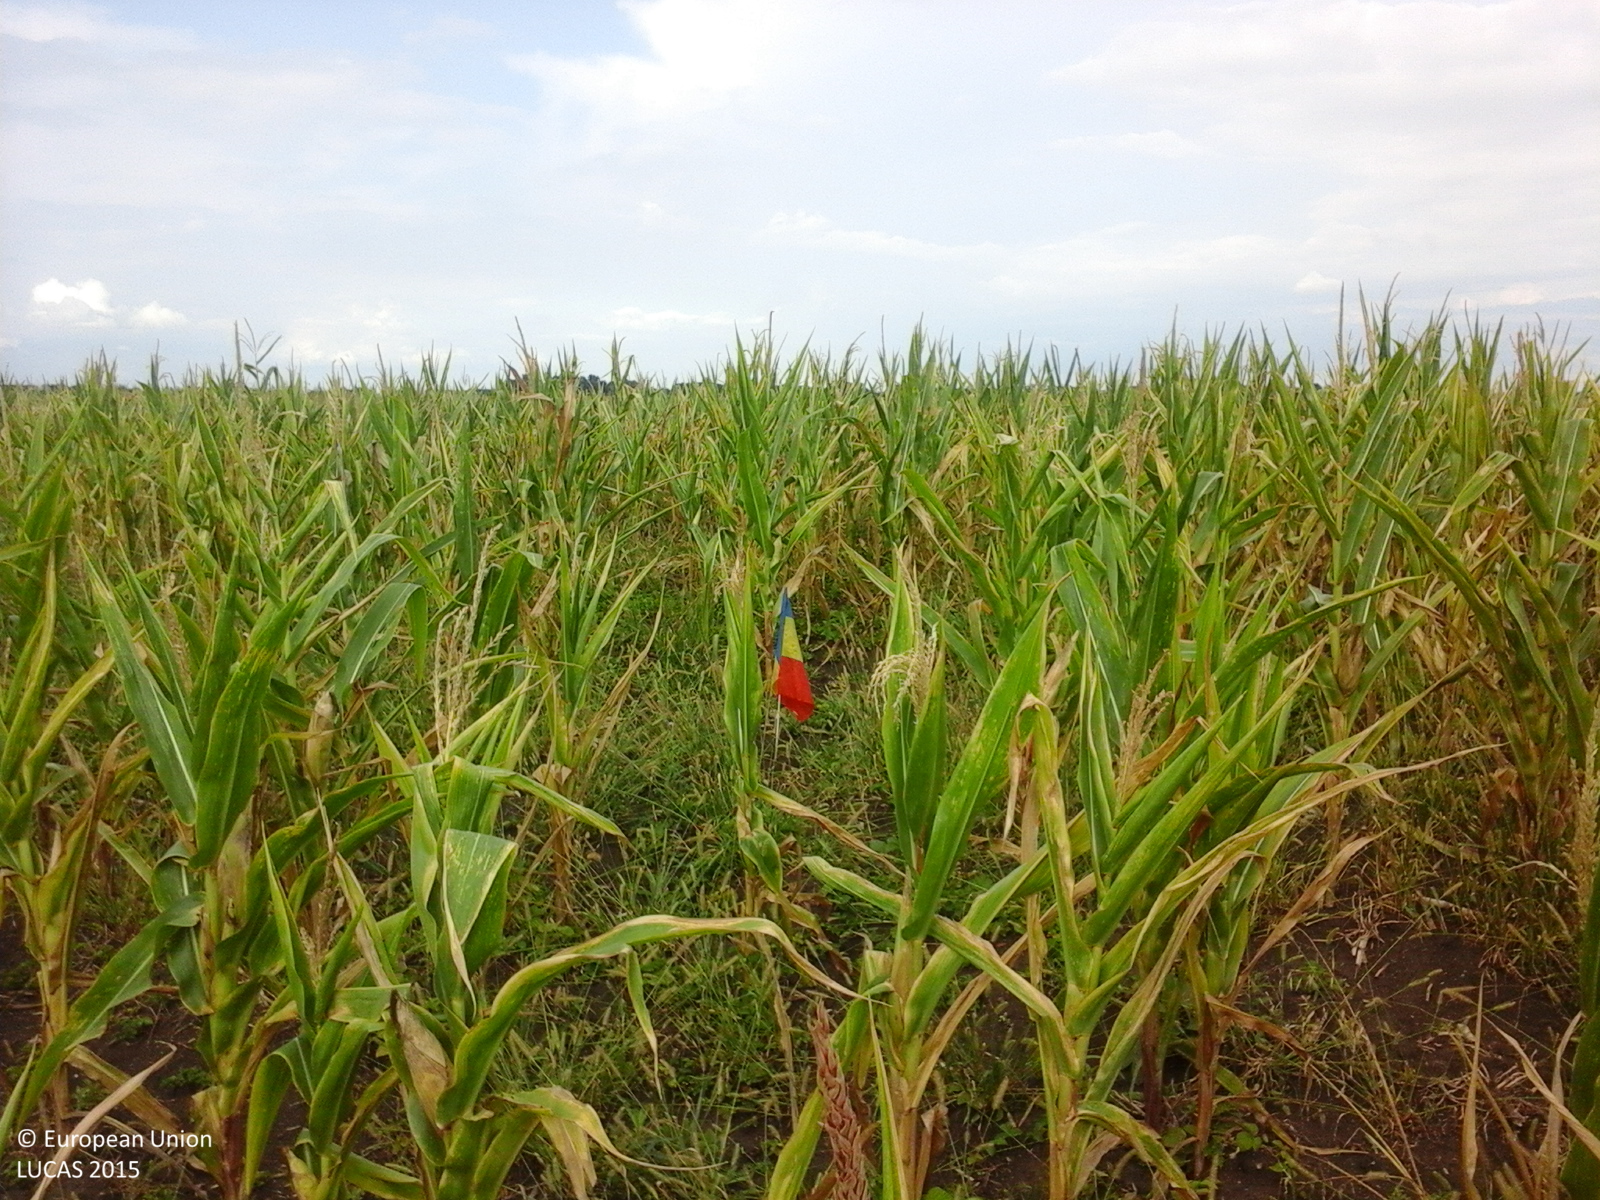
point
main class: Cropland
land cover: Maize
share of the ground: > 75 %
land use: Agriculture (excluding fallow land and kitchen gardens)
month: August
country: RO
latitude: 45.5911
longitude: 21.4275
